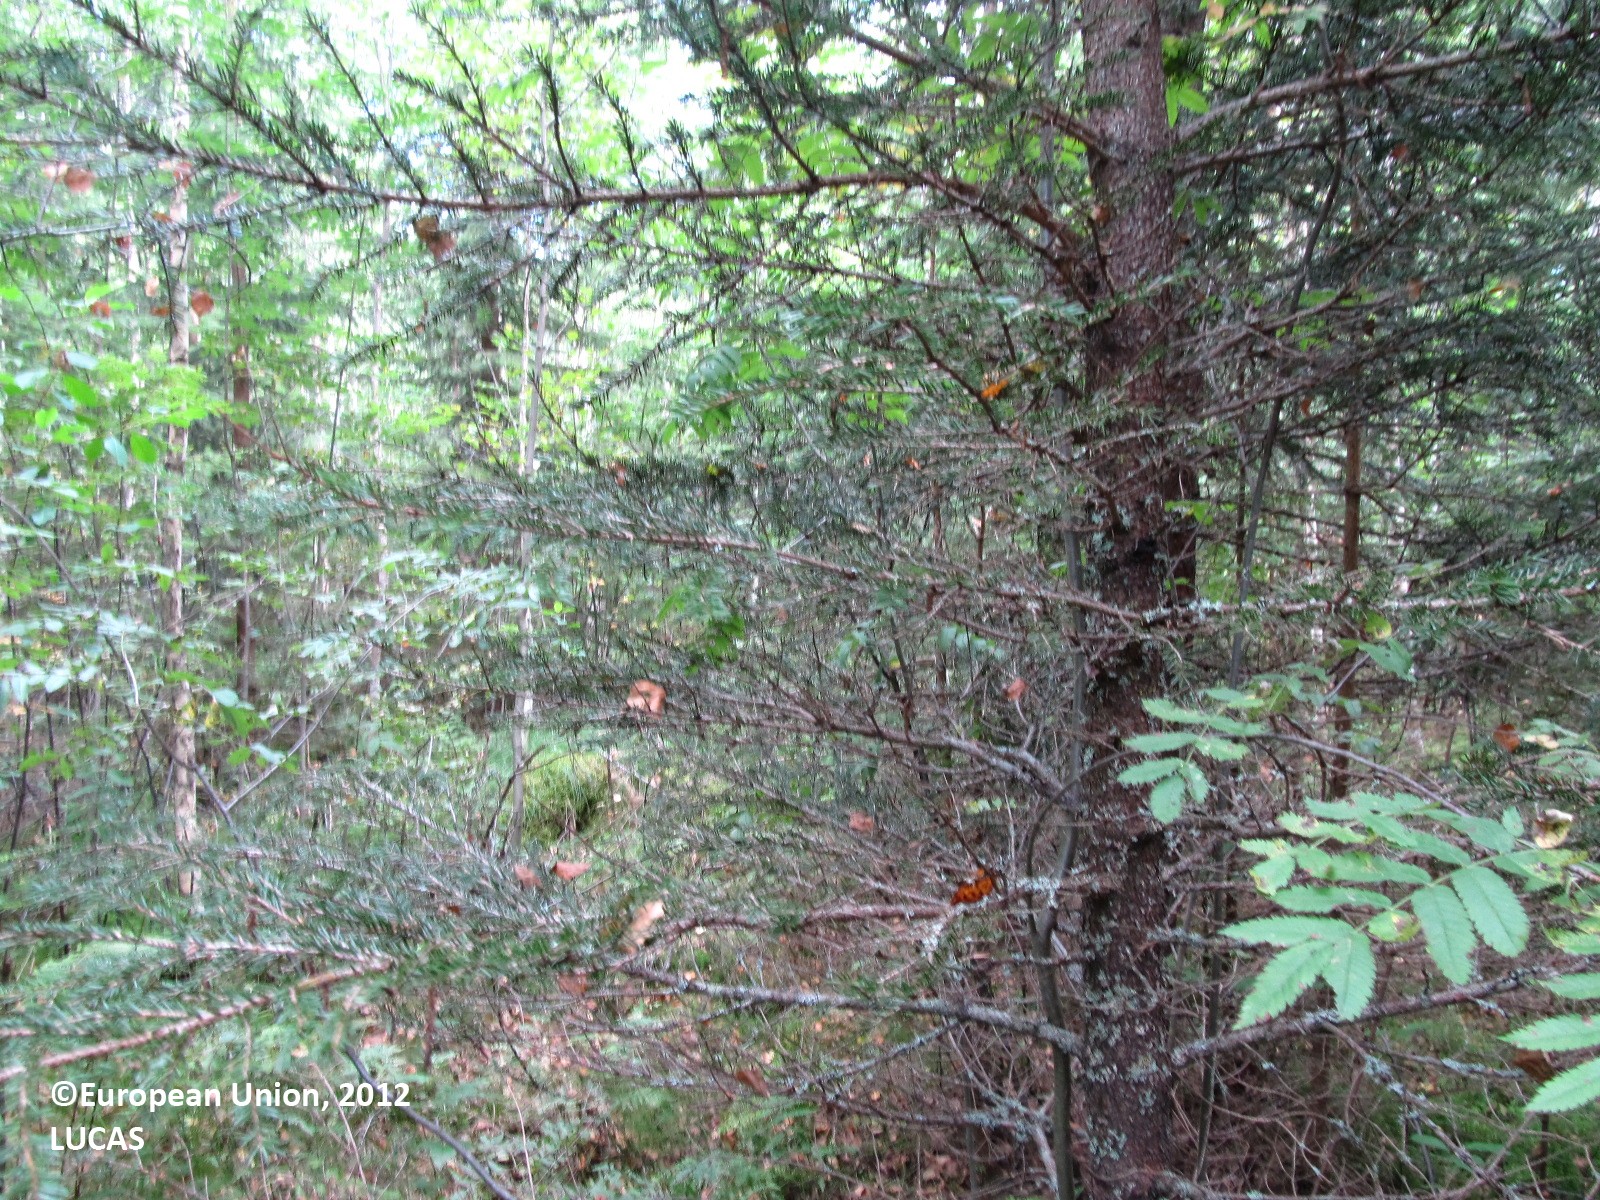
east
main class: Woodland
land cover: Spruce dominated mixed woodland
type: boreal forest
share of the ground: 50 - 75 %
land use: Forestry
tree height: > 5 m
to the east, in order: Spruce dominated mixed woodland; Temporary grasslands
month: August
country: FI
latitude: 61.8186
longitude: 27.7790
